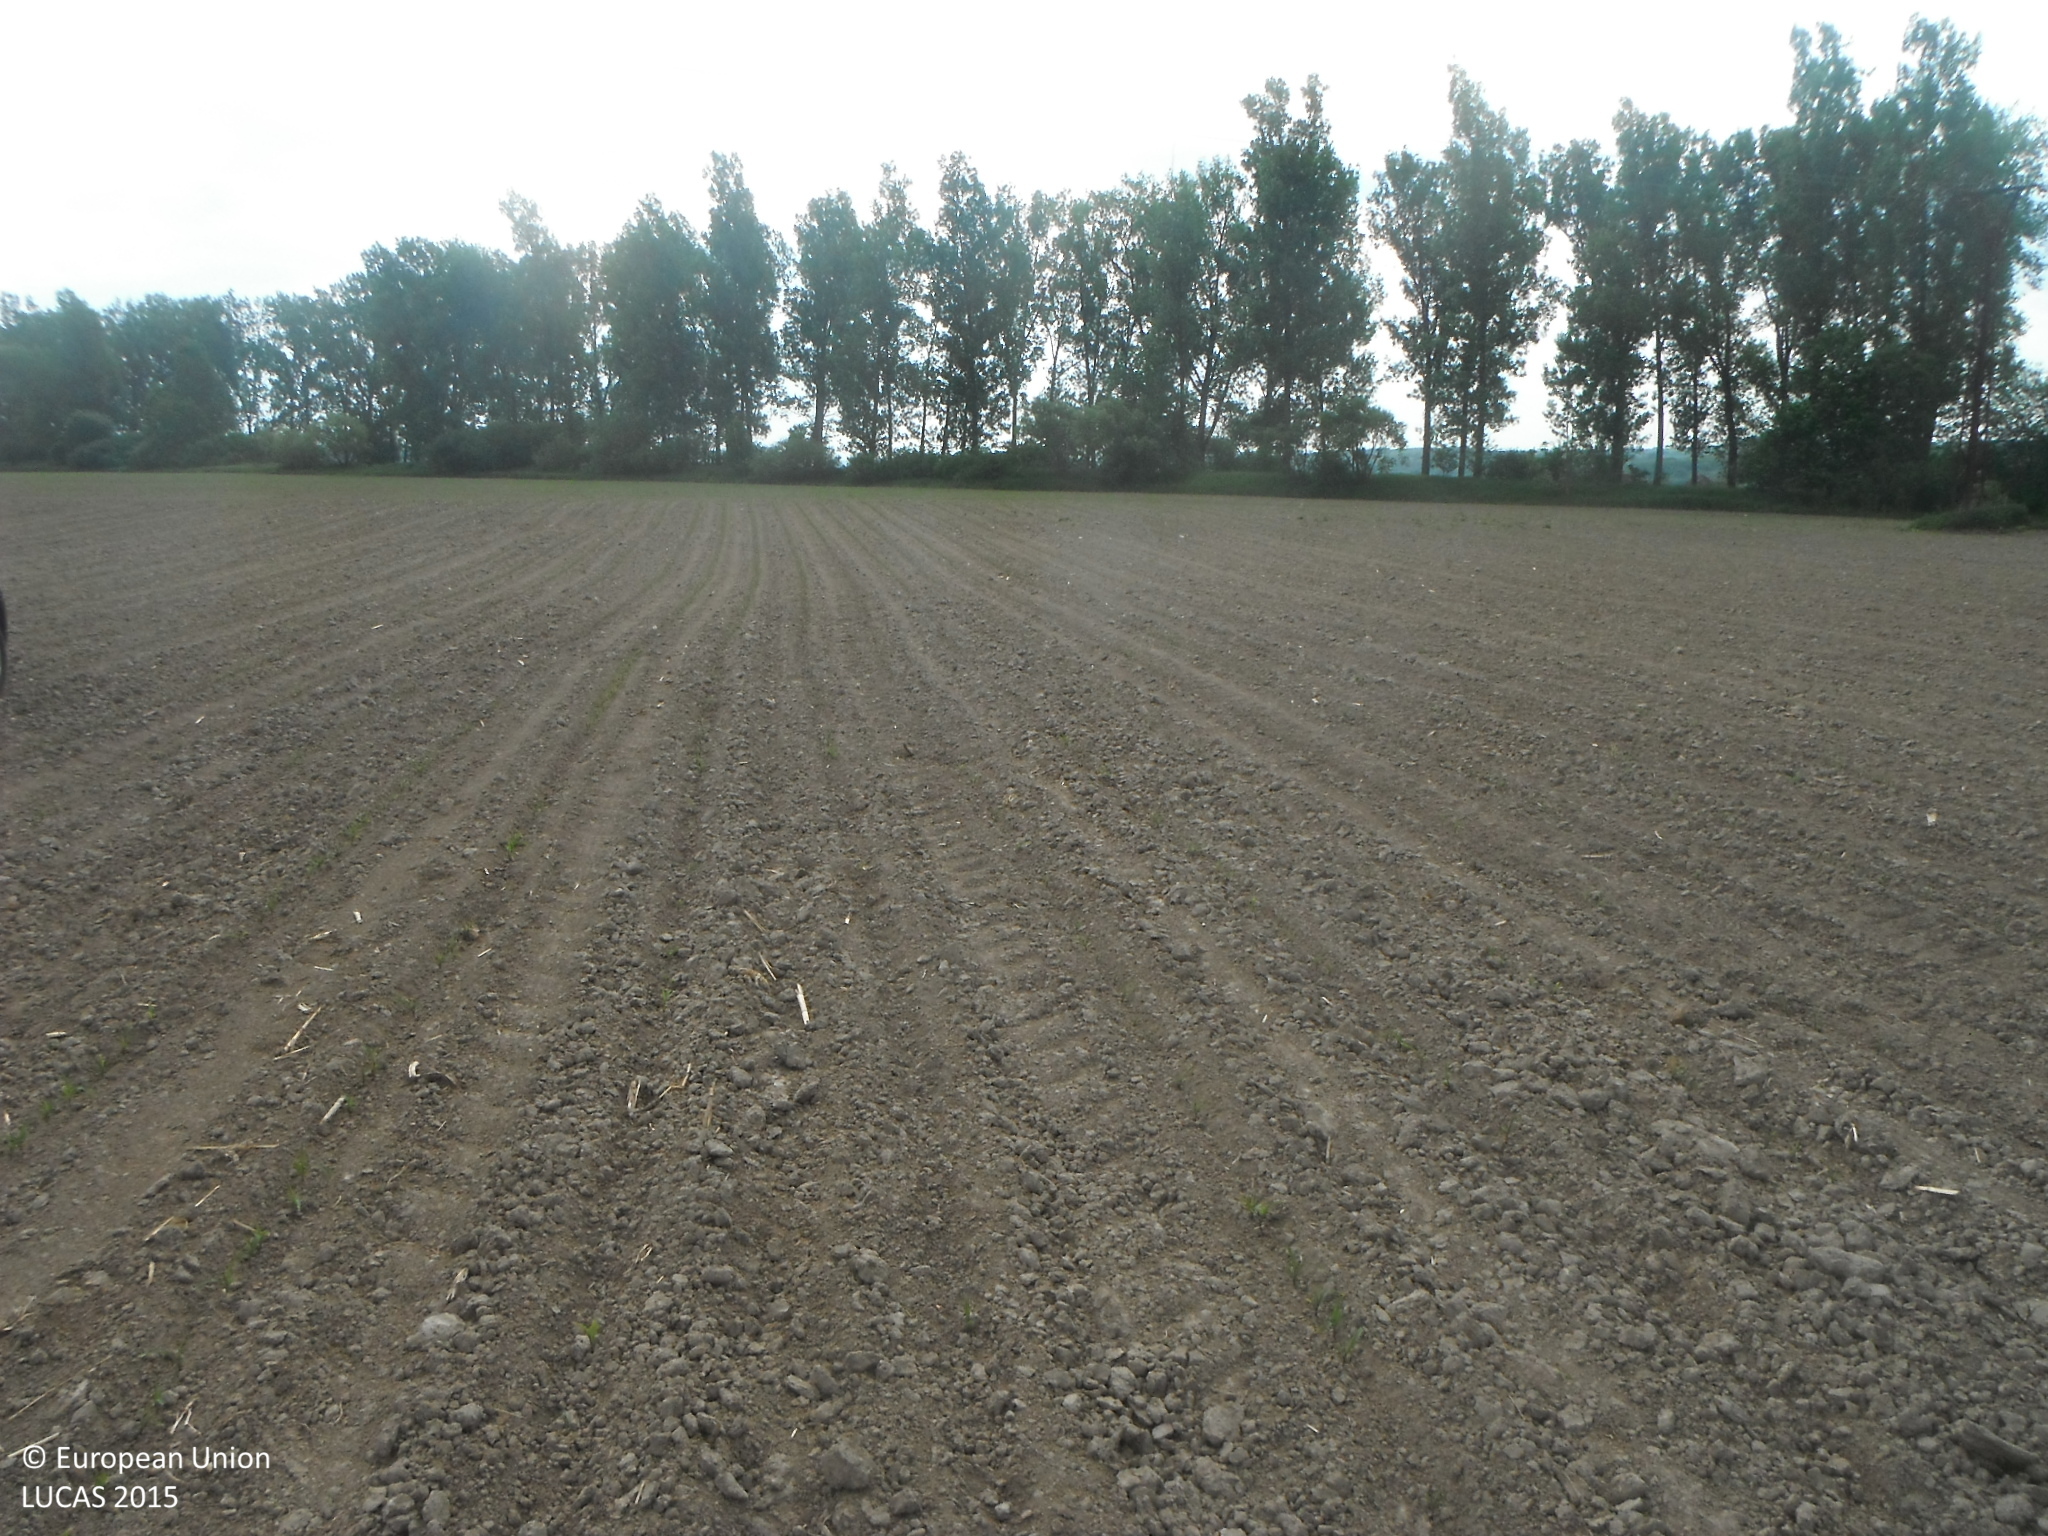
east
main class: Cropland
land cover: Maize
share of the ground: < 10 %
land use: Agriculture (excluding fallow land and kitchen gardens)
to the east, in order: Maize; Electric lines; Maize; Shrubland with sparse tree cover; Grass margins; Inland fresh running water
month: May
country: SK
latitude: 48.5634
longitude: 20.9759
